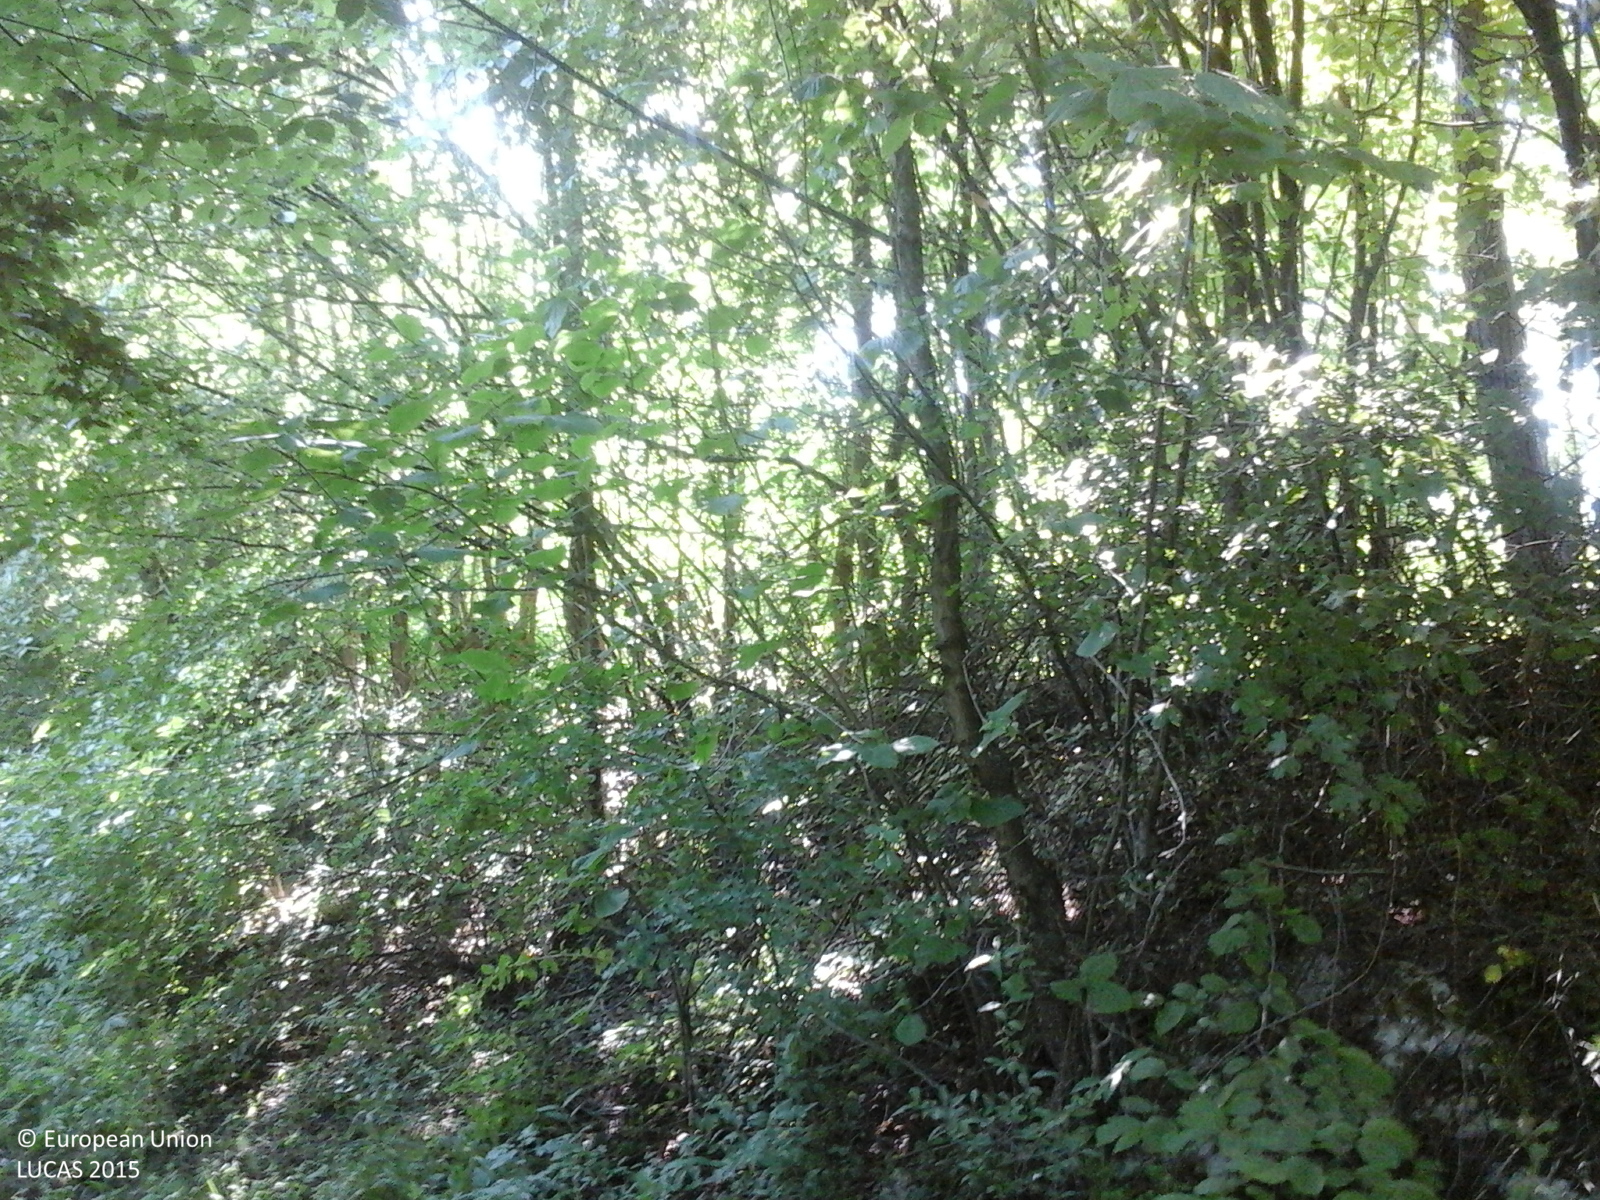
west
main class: Woodland
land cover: Broadleaved woodland
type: beech forest
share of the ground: > 75 %
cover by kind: broadleaved forest trees 100 %
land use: Forestry
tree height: > 5 m
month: June
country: RO
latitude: 45.1135
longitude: 25.6724
